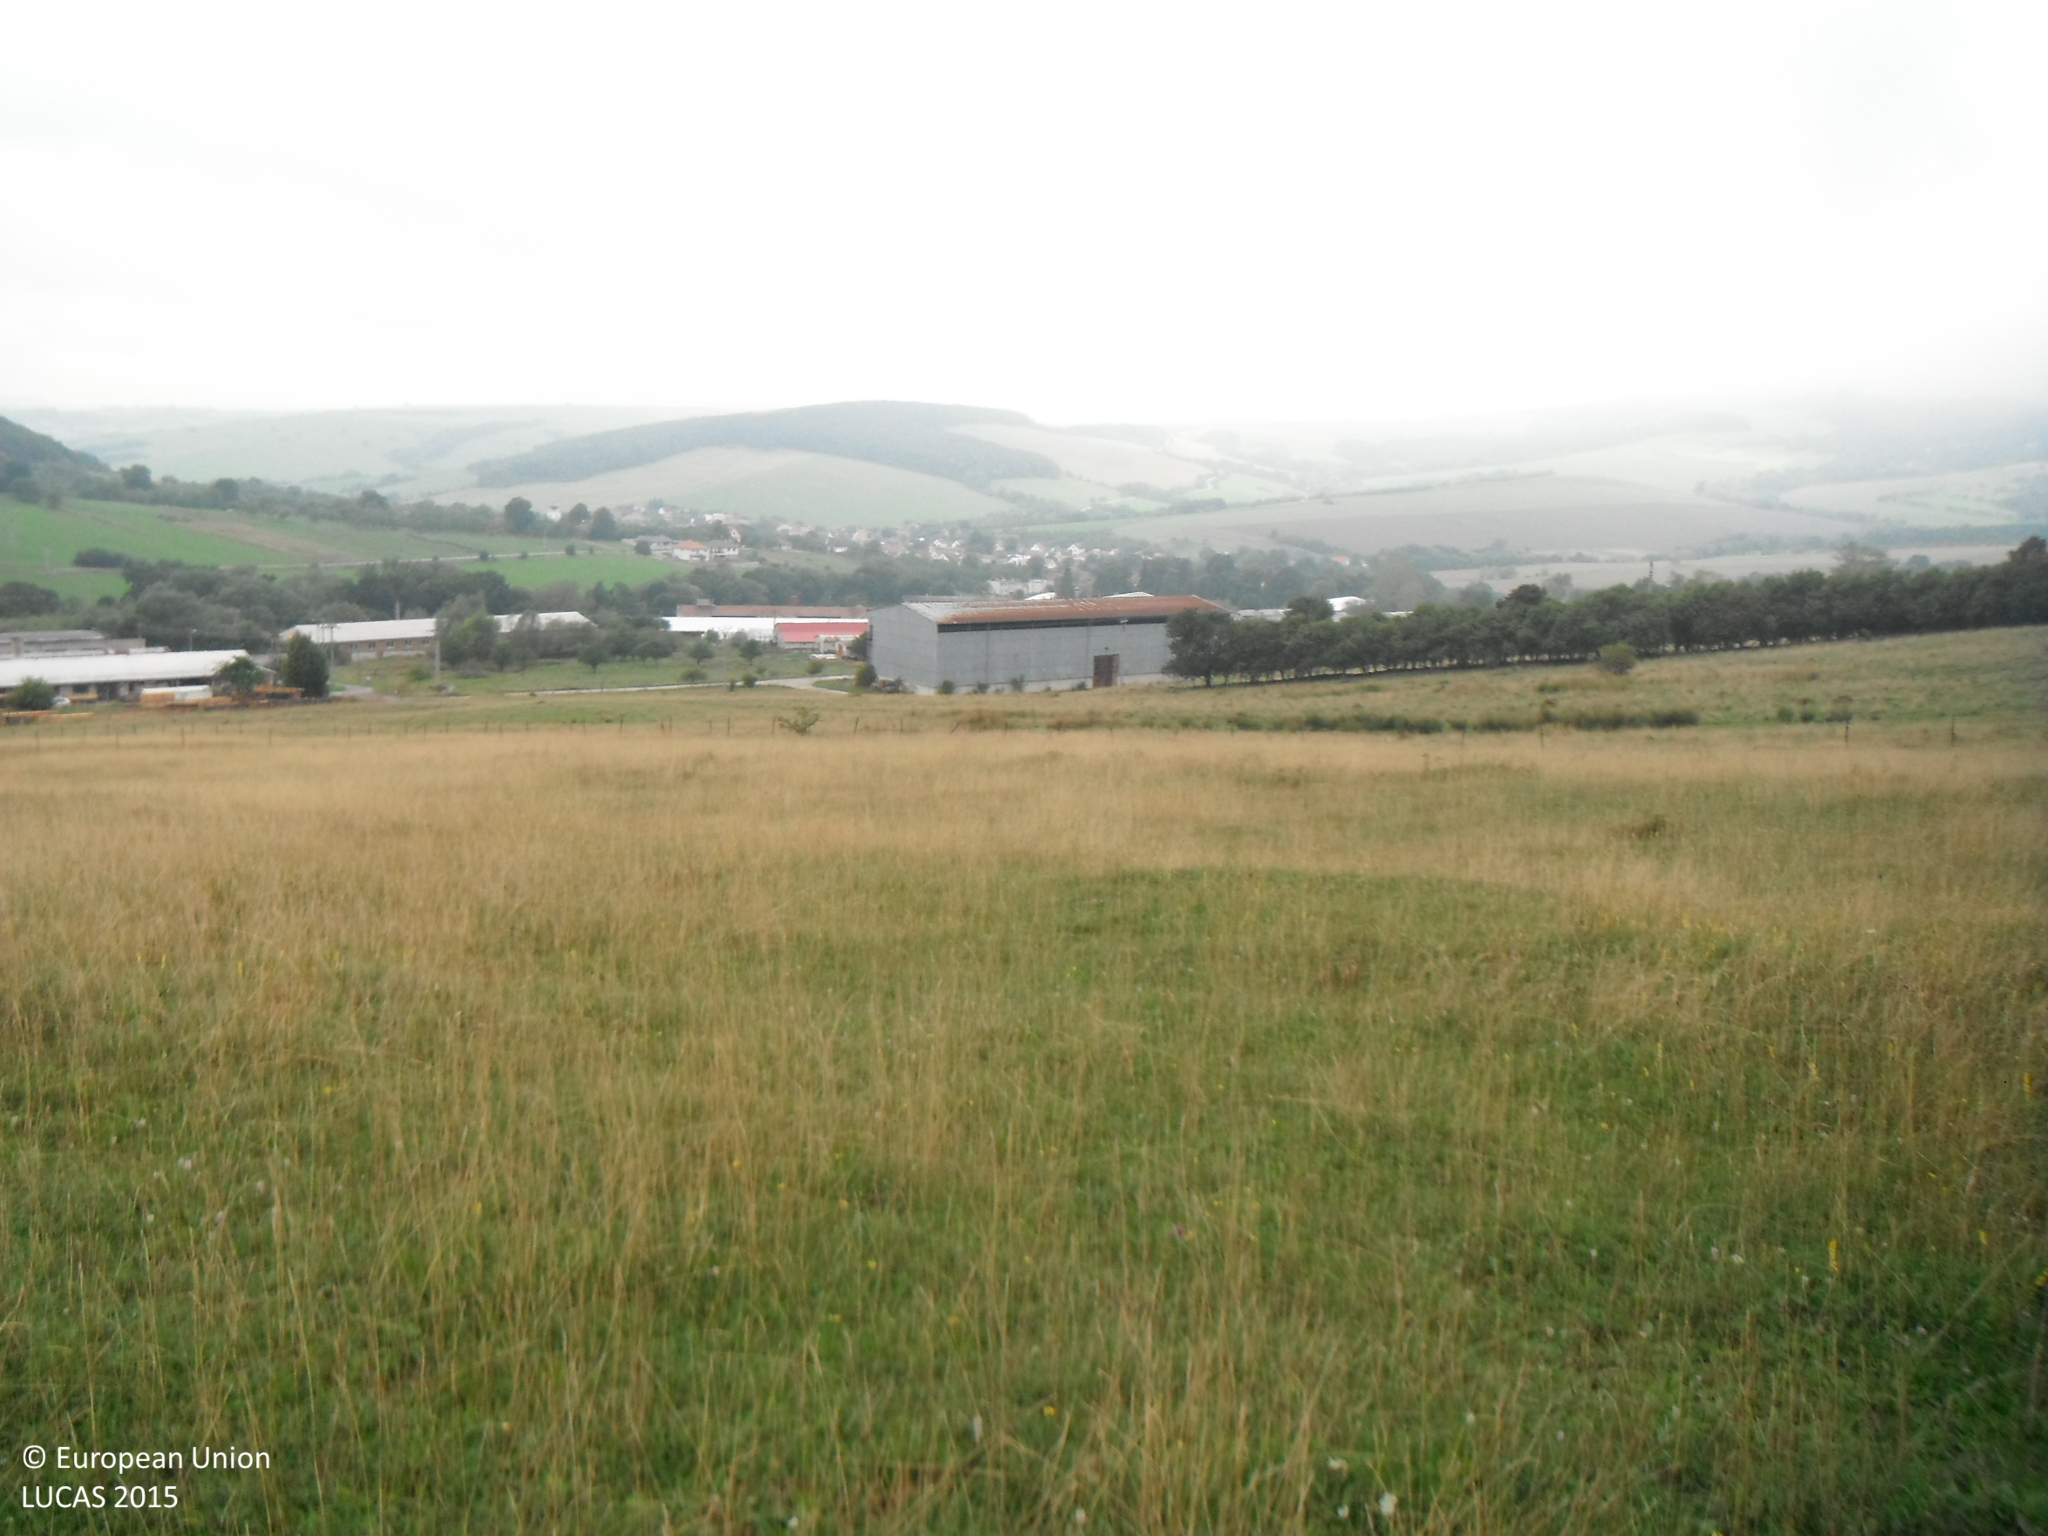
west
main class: Grassland
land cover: Grassland without tree/shrub cover
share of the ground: > 75 %
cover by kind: herbaceous plants 95 %, shrubs 5 %
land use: Agriculture (excluding fallow land and kitchen gardens)
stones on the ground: < 10 %
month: September
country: SK
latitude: 48.8000
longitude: 17.4853
